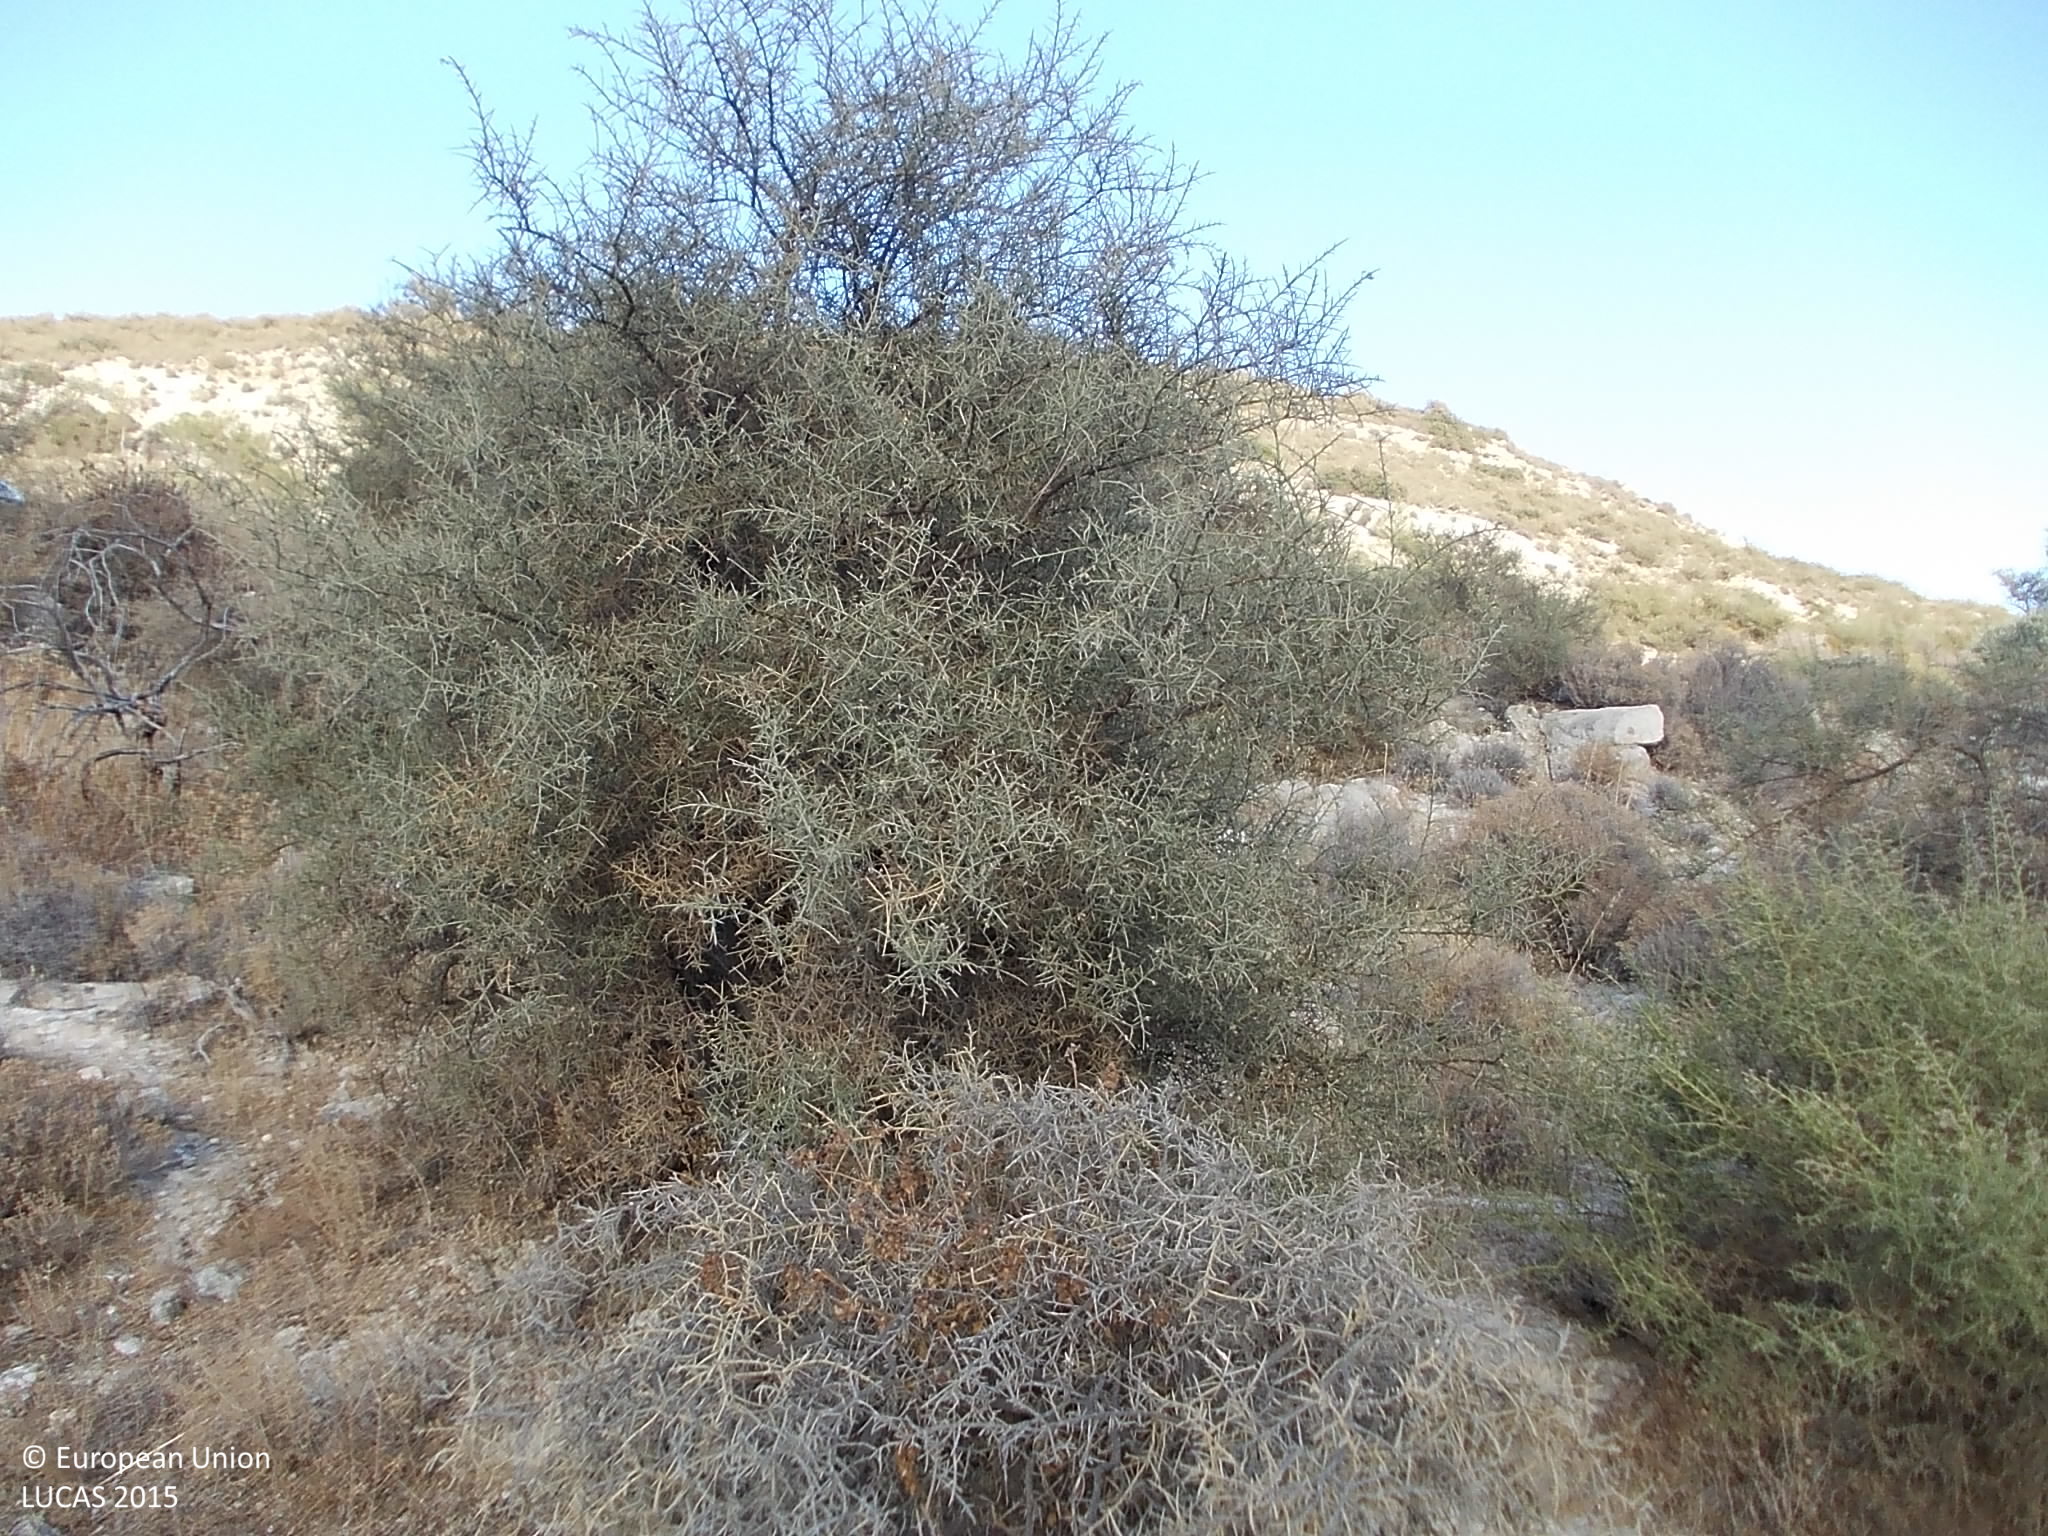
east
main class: Shrubland
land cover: Shrubland without tree cover
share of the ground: 50 - 75 %
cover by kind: shrubs 60 %, consolidated bare surface 20 %, herbaceous plants 10 %, unconsolidated bare surface 10 %
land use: Semi-natural and natural areas not in use
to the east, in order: Shrubland without tree cover; Tracks; Shrubland without tree cover; Tracks; Shrubland without tree cover; Tracks; Shrubland without tree cover
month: September
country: CY
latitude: 34.7064
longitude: 32.9022
